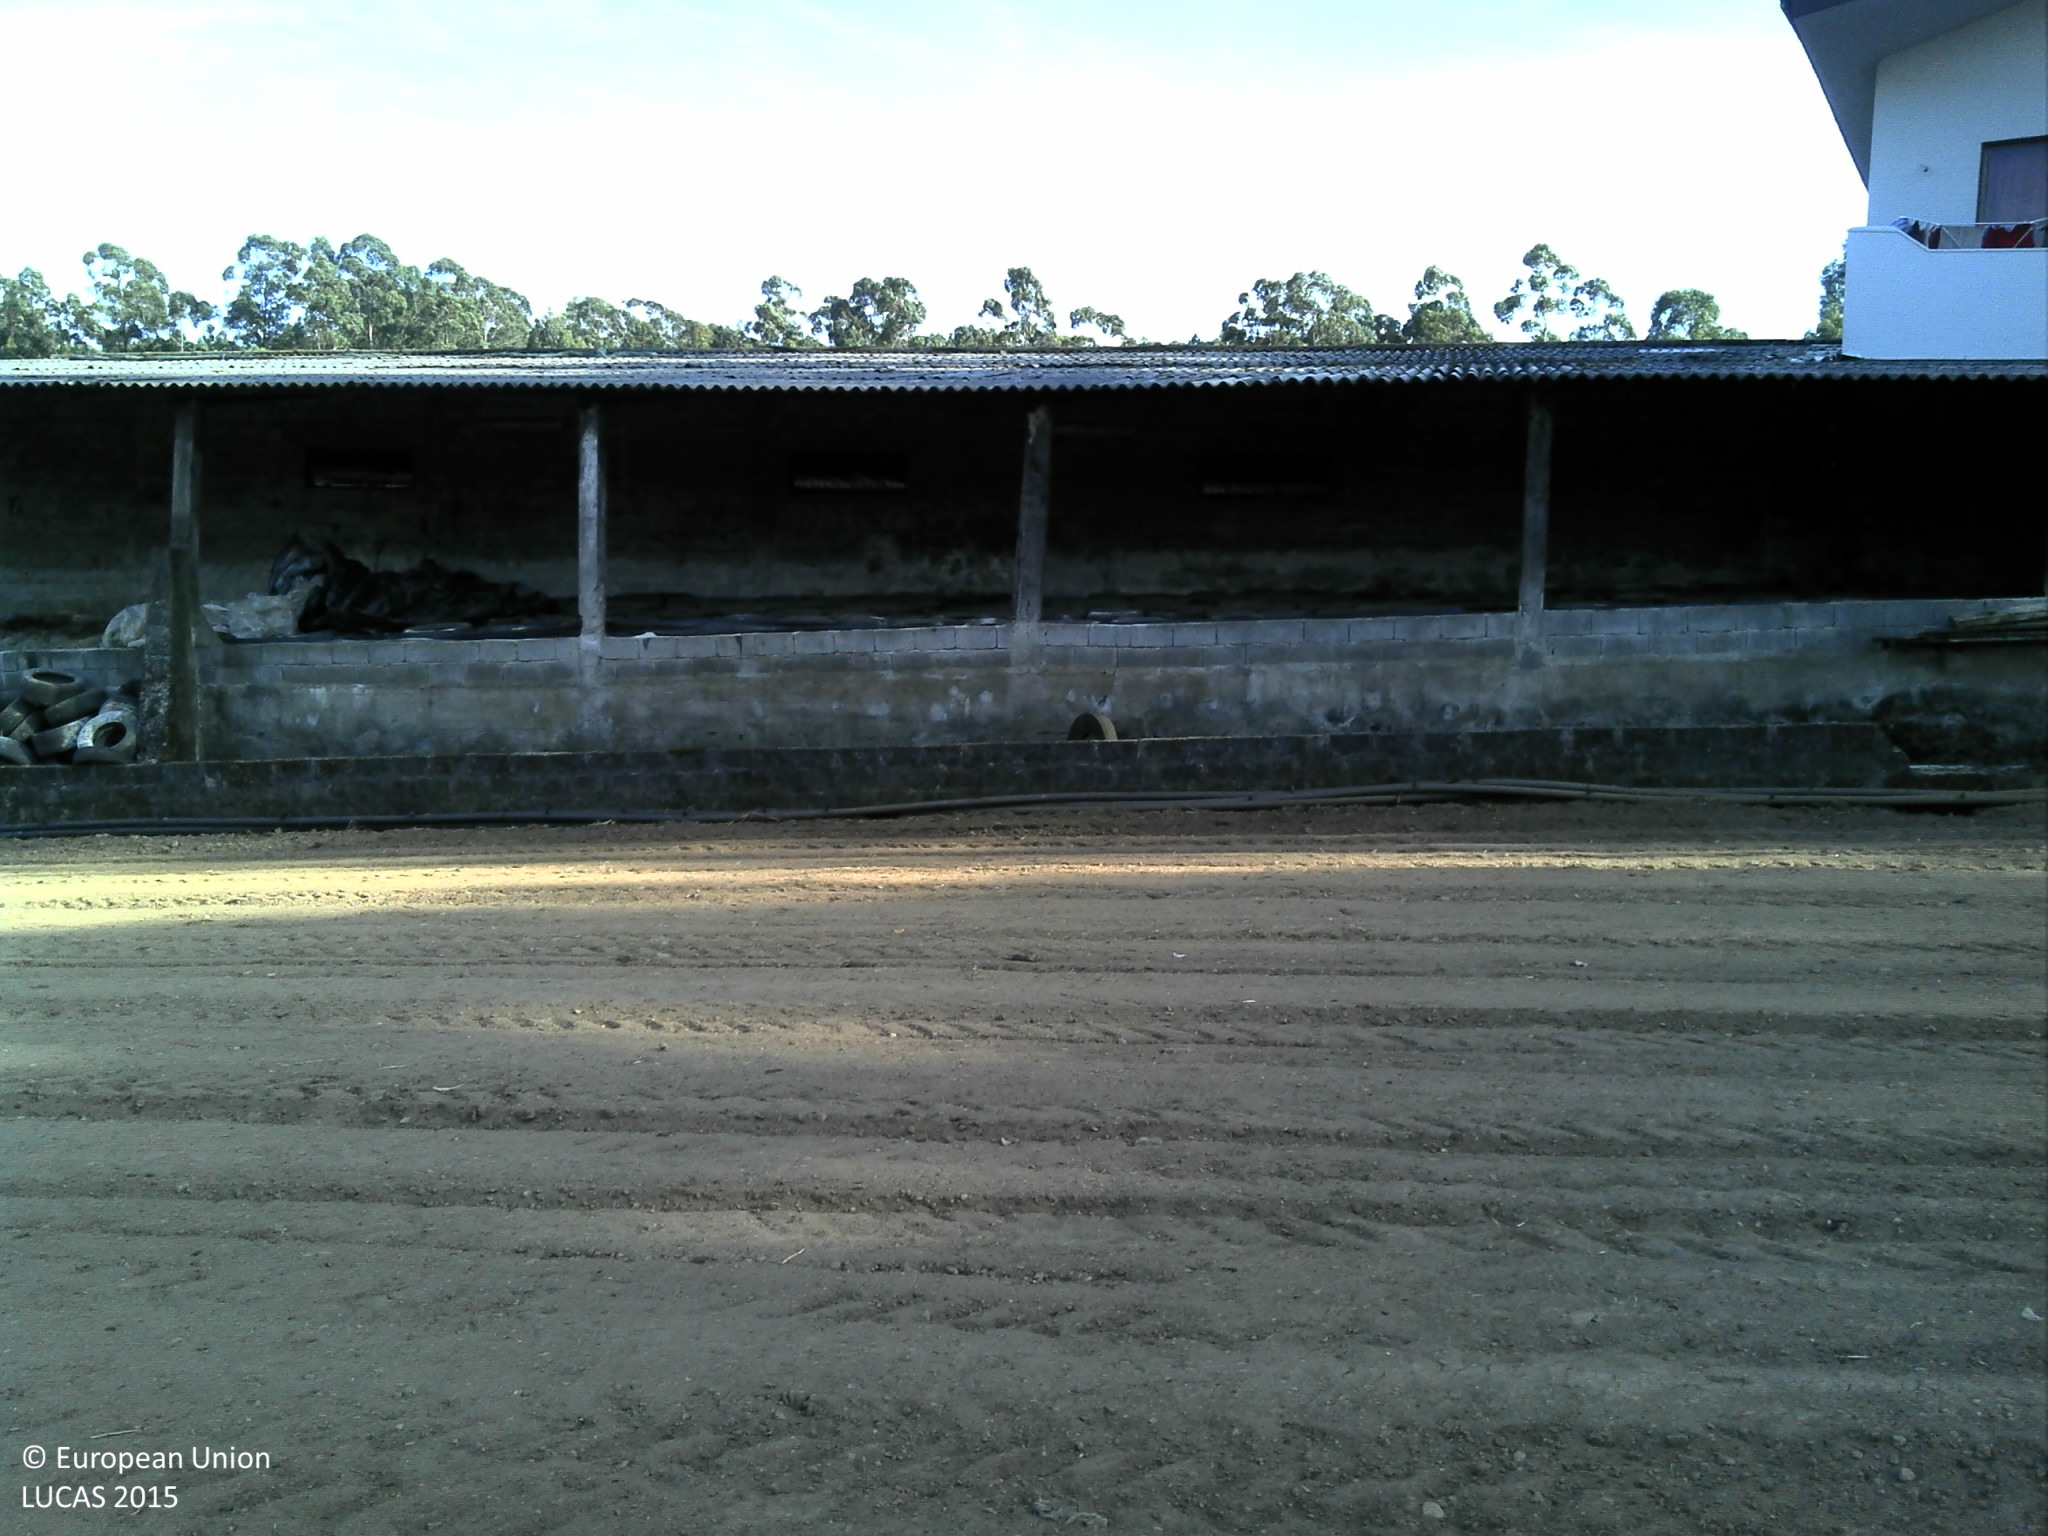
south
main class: Cropland
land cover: Maize
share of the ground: < 10 %
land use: Agriculture (excluding fallow land and kitchen gardens)
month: May
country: PT
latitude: 41.4136
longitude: -8.5924
